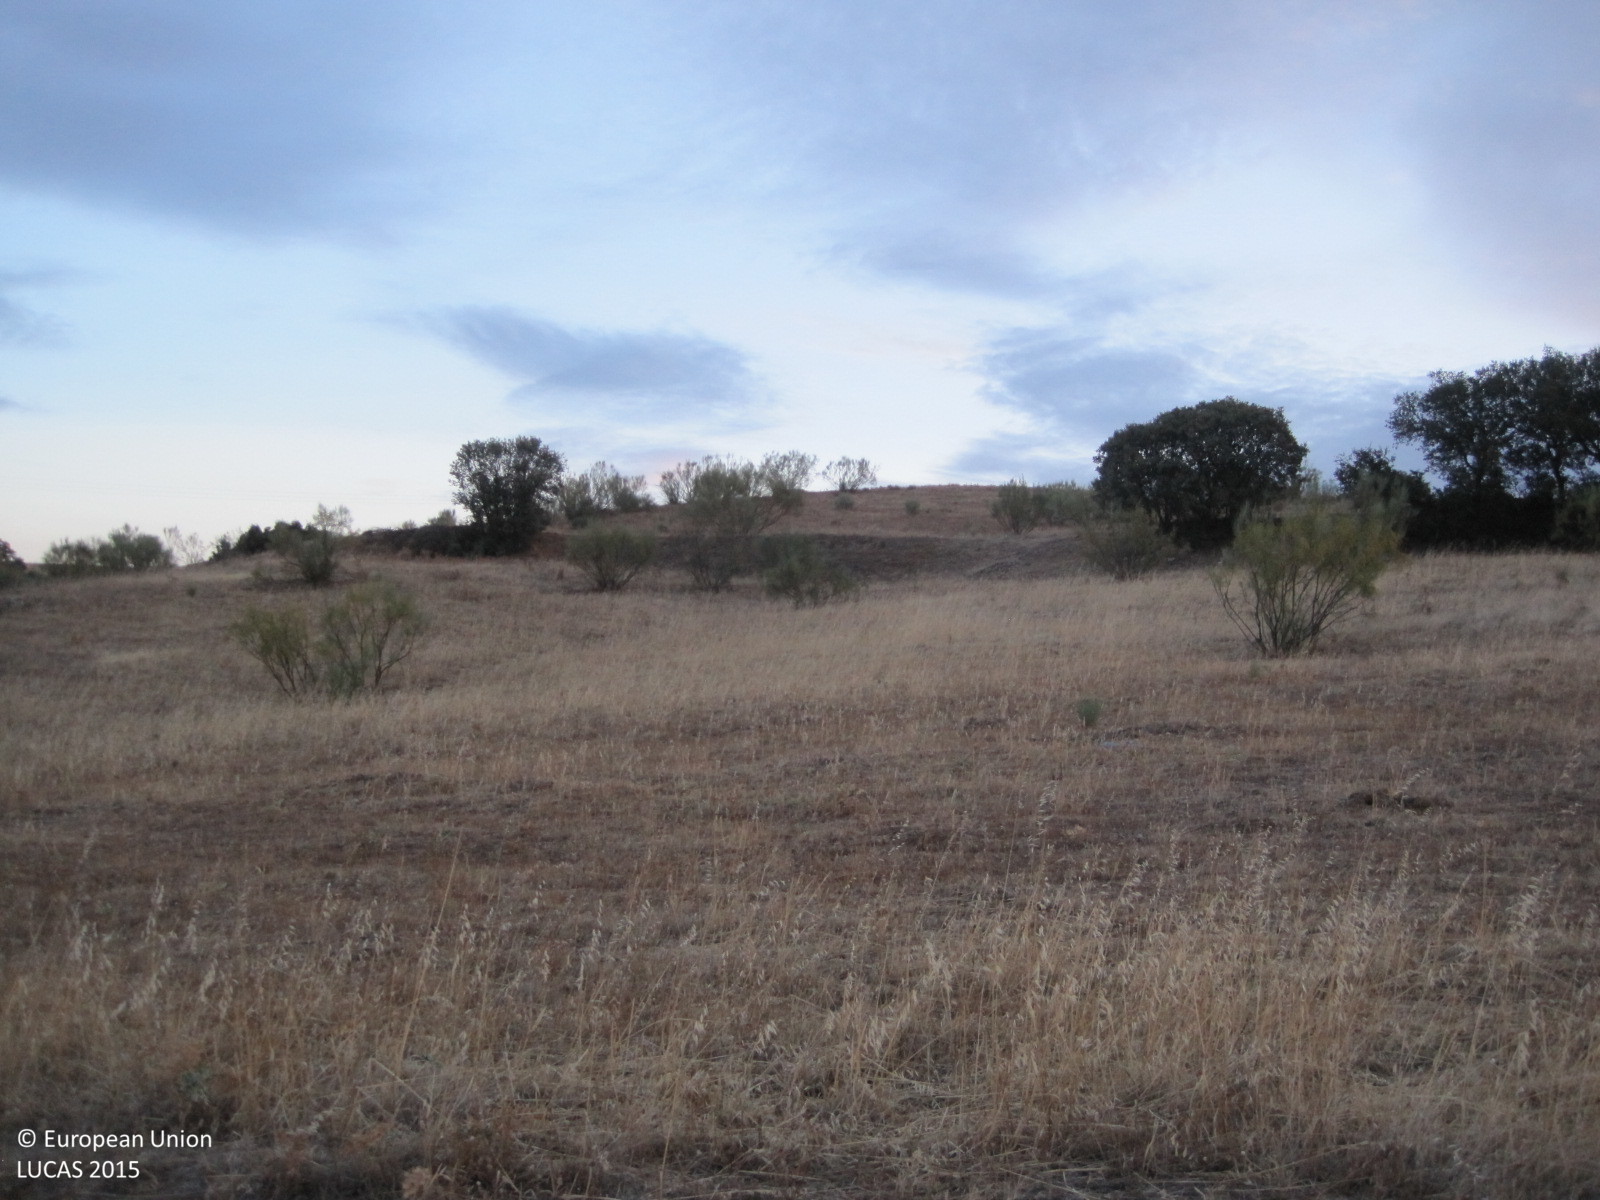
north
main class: Grassland
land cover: Grassland without tree/shrub cover
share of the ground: > 75 %
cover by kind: herbaceous plants 100 %
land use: Agriculture (excluding fallow land and kitchen gardens)
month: July
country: ES
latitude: 40.2303
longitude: -4.3712
